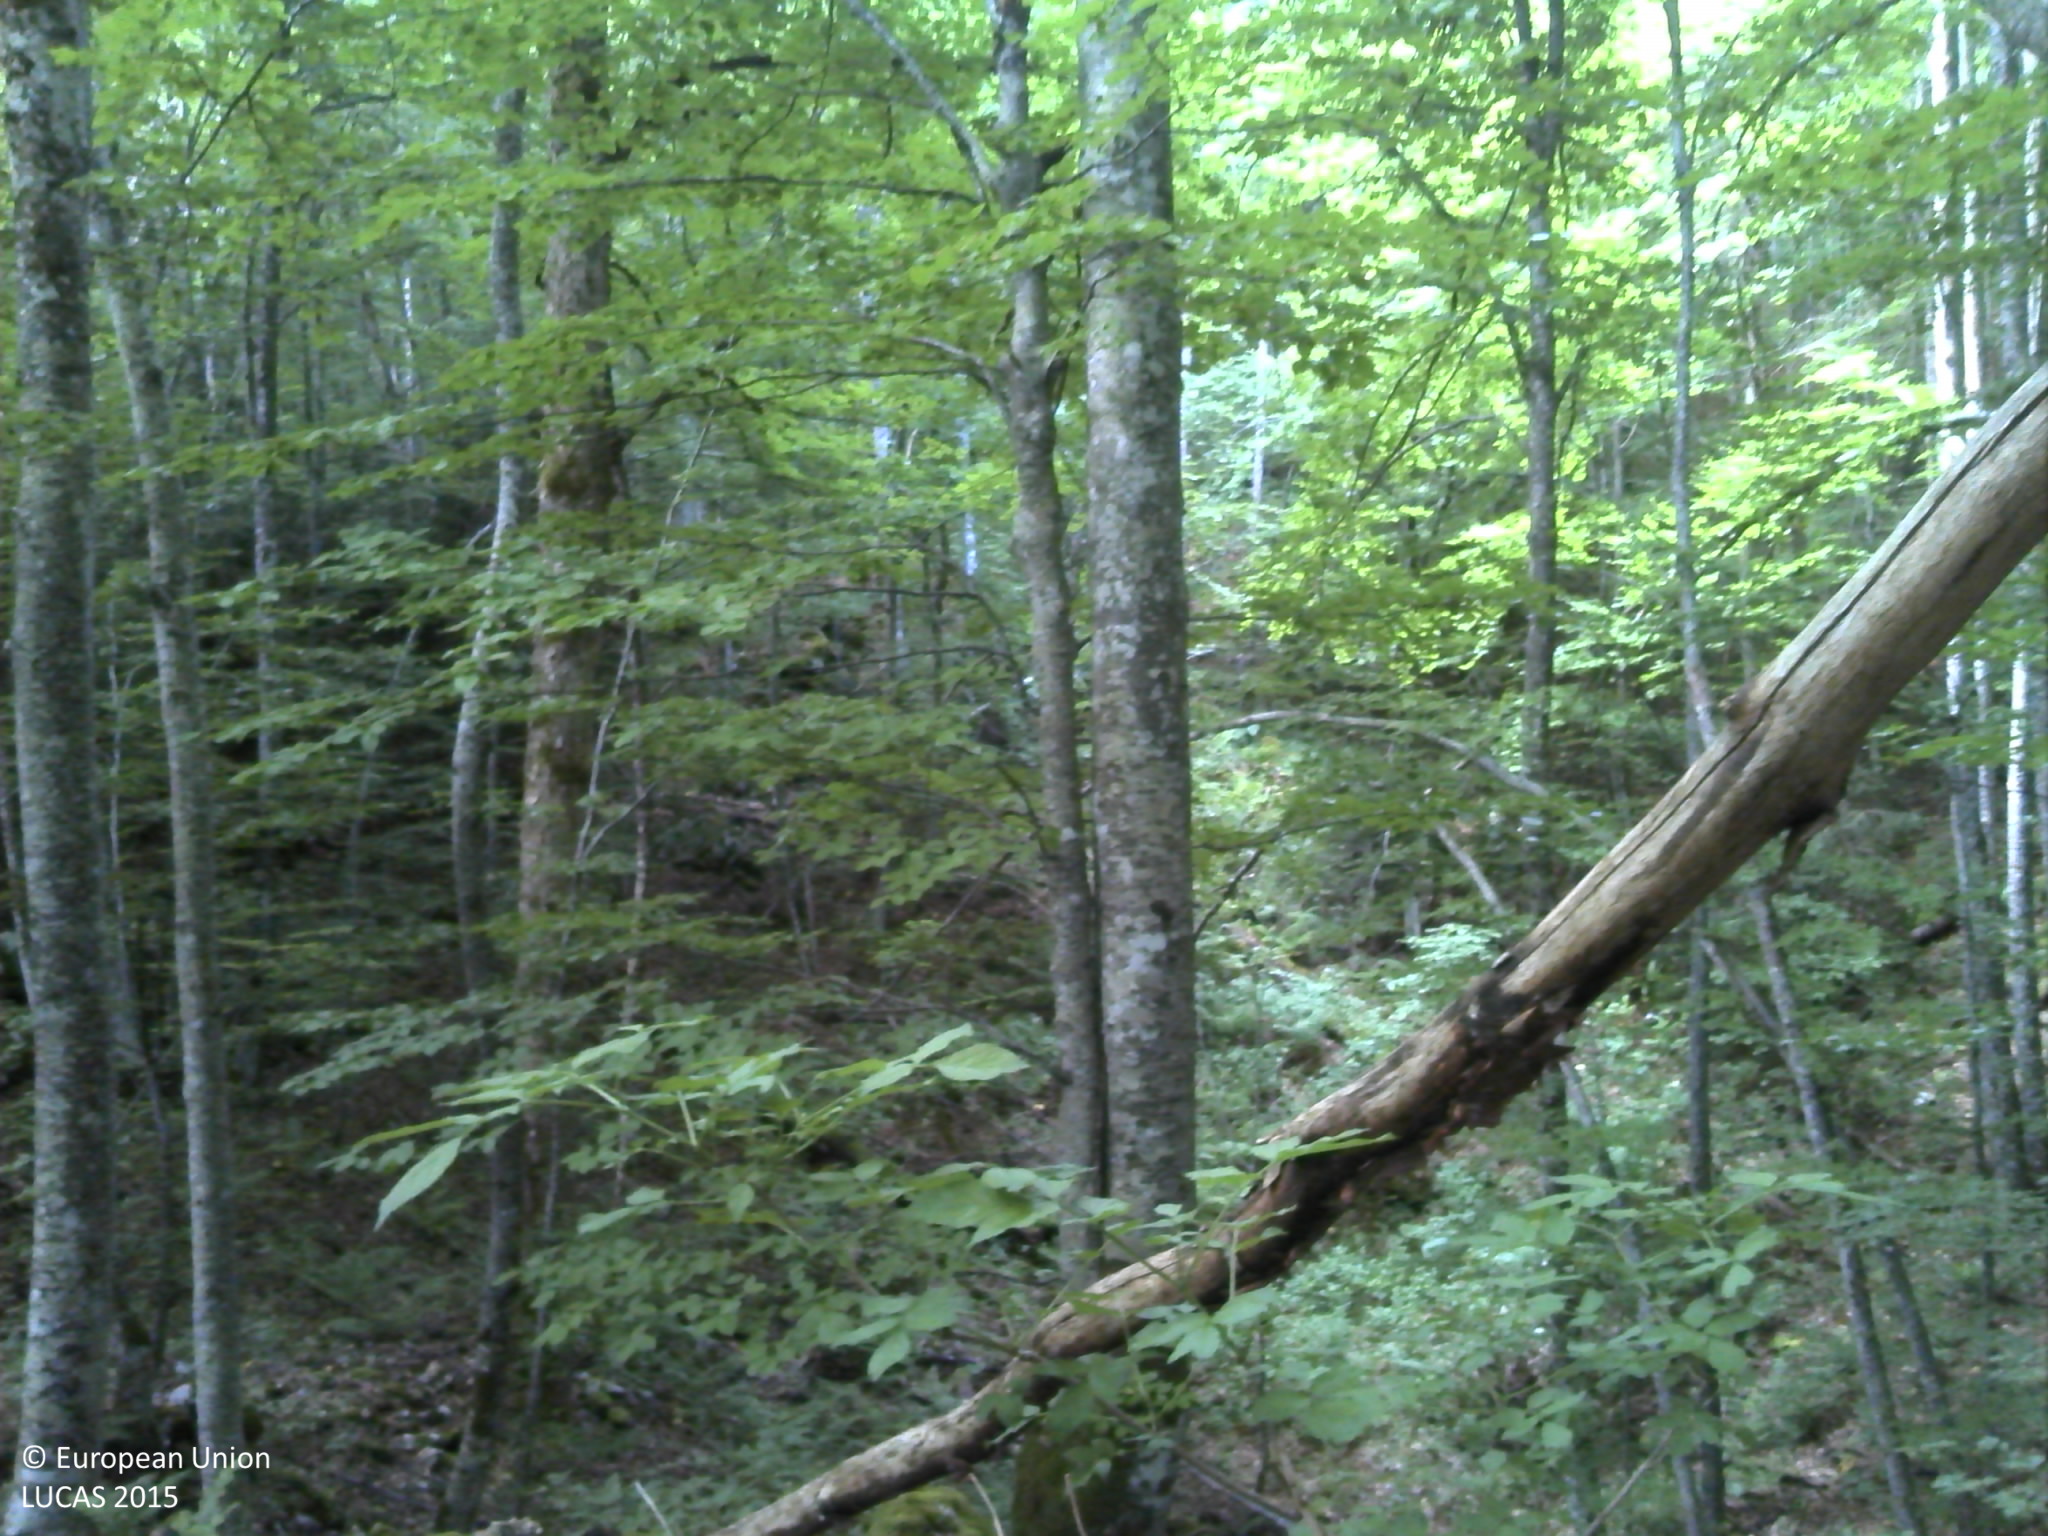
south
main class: Woodland
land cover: Broadleaved woodland
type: mountainous beech forest
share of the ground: > 75 %
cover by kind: broadleaved forest trees 90 %, consolidated bare surface 10 %
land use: Forestry
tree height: > 5 m
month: June
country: HR
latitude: 44.5983
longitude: 15.9026
